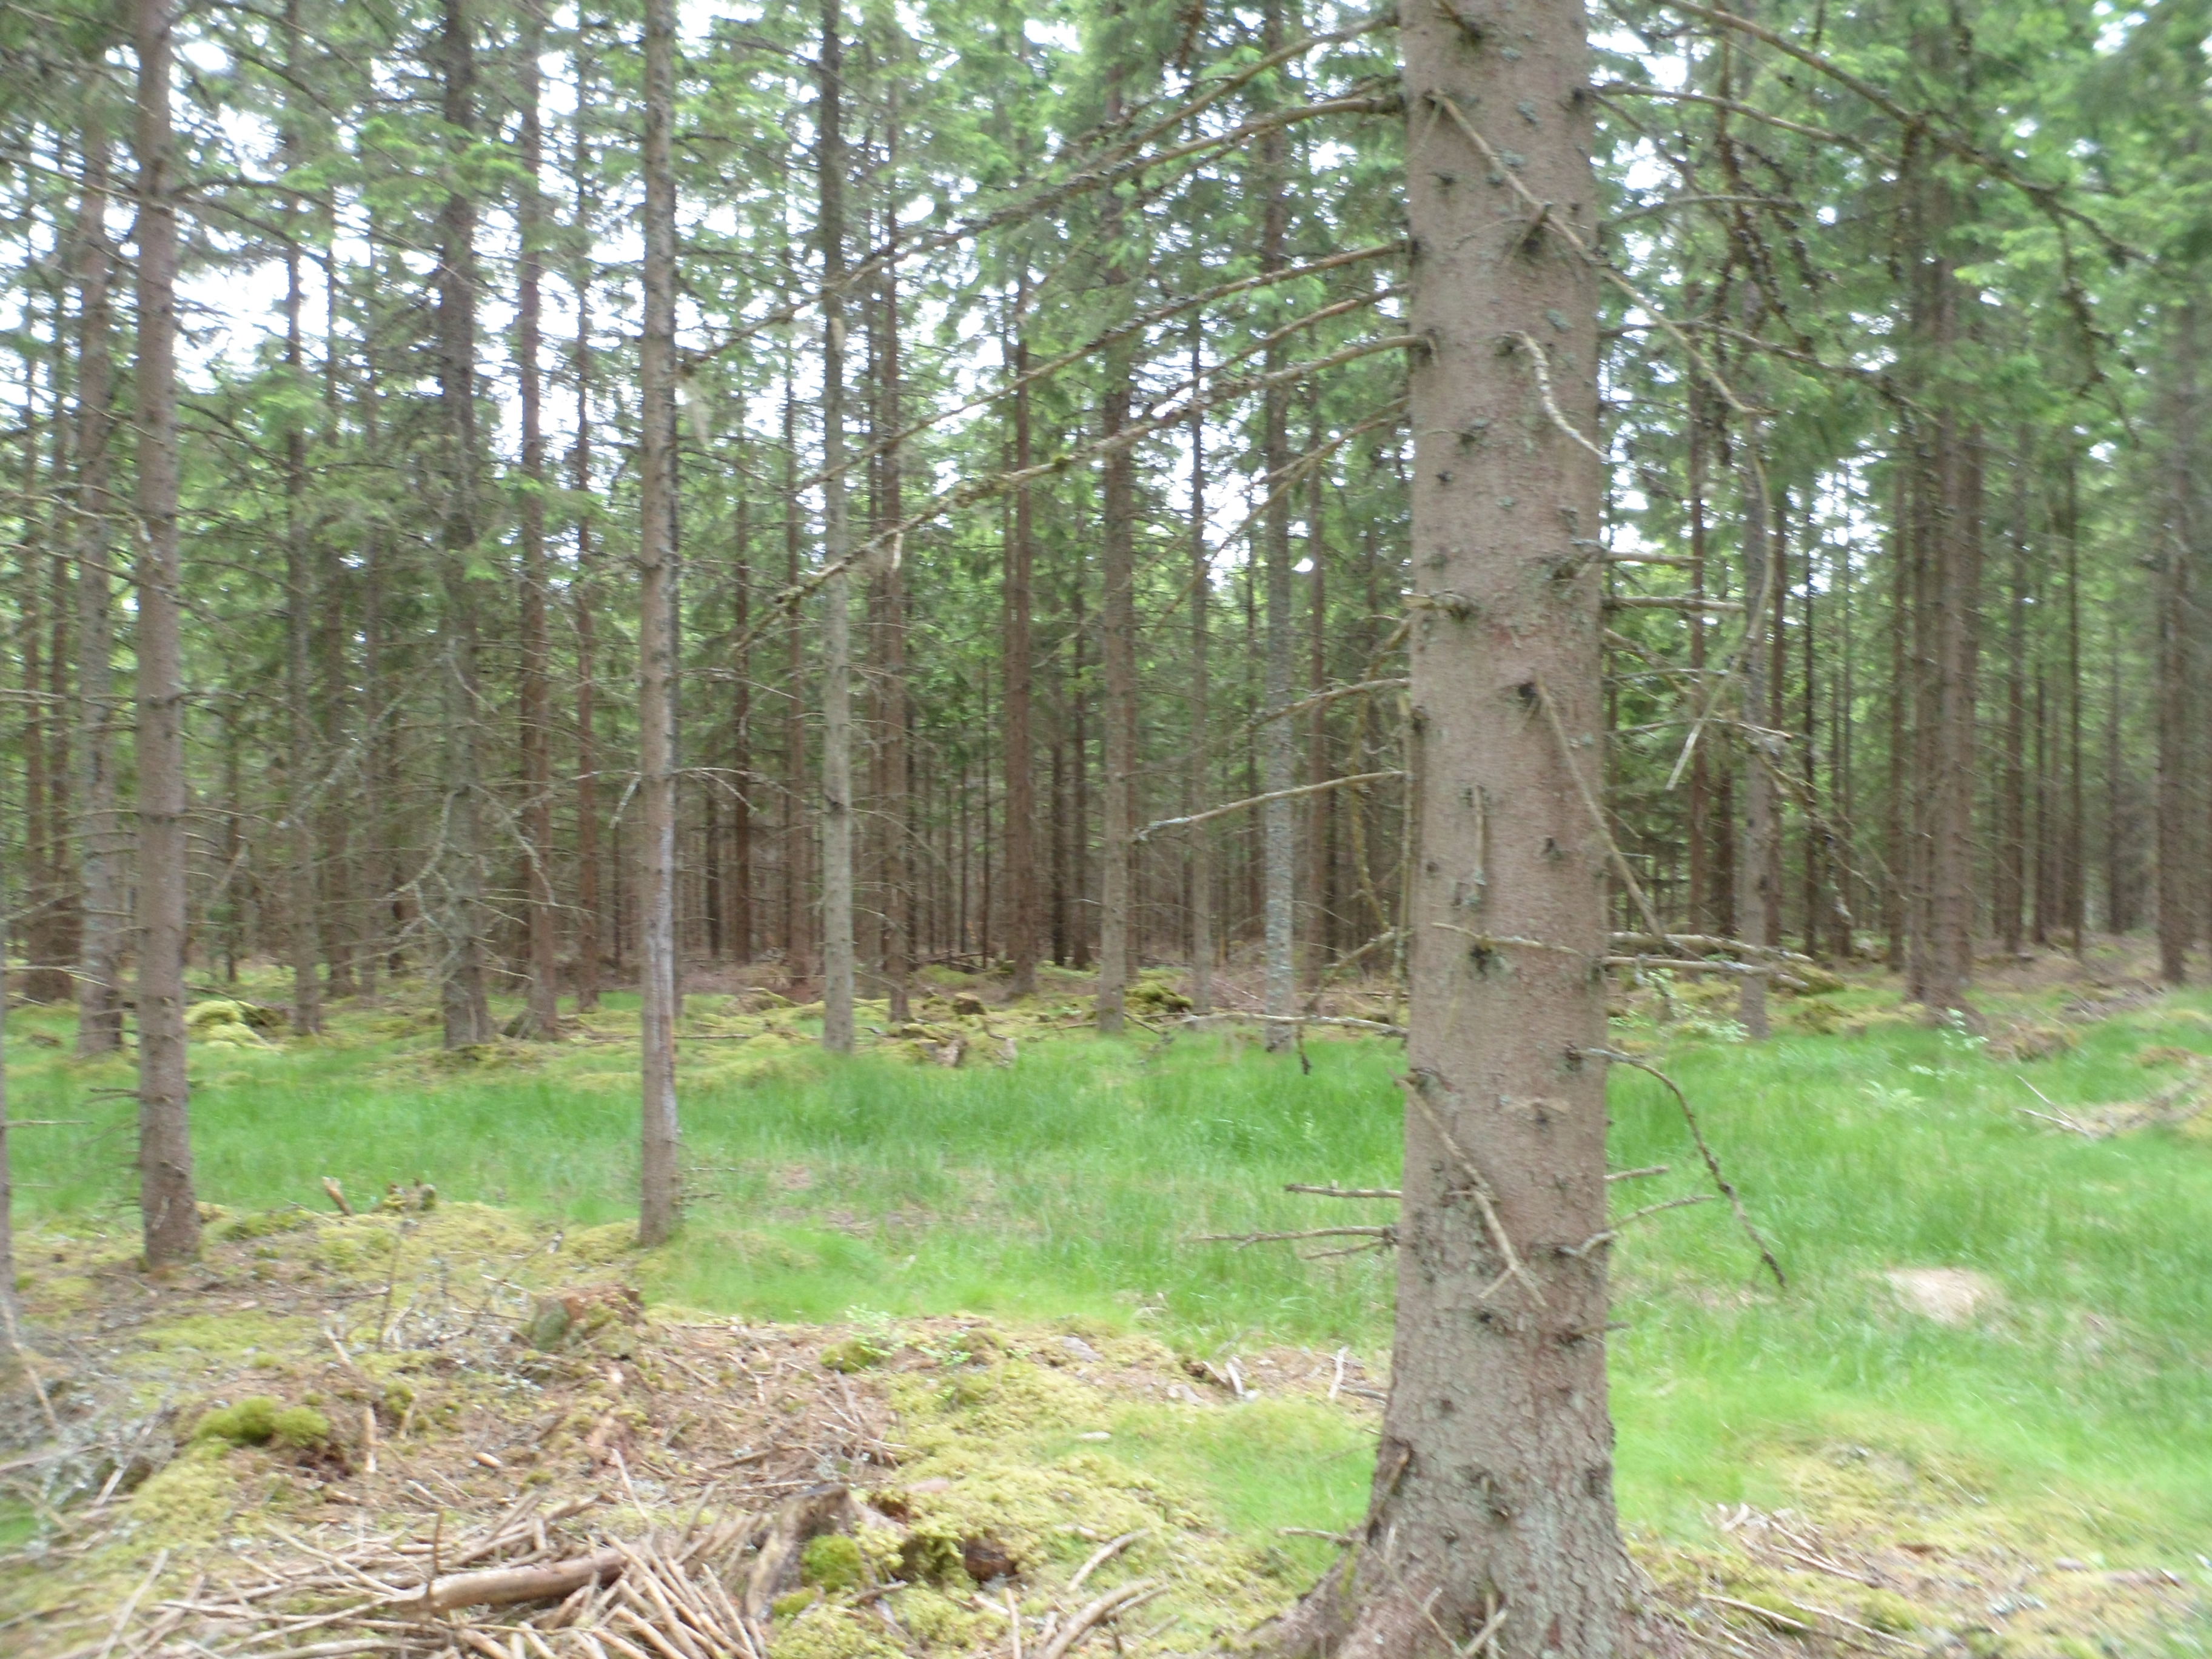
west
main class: Woodland
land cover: Spruce dominated coniferous woodland
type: boreal forest
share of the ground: 50 - 75 %
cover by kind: coniferous forest trees 60 %, herbaceous plants 15 %, lichens and mosses 15 %, shrubs 10 %
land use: Forestry
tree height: > 5 m
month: June
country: SE
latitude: 57.3740
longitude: 14.3695
